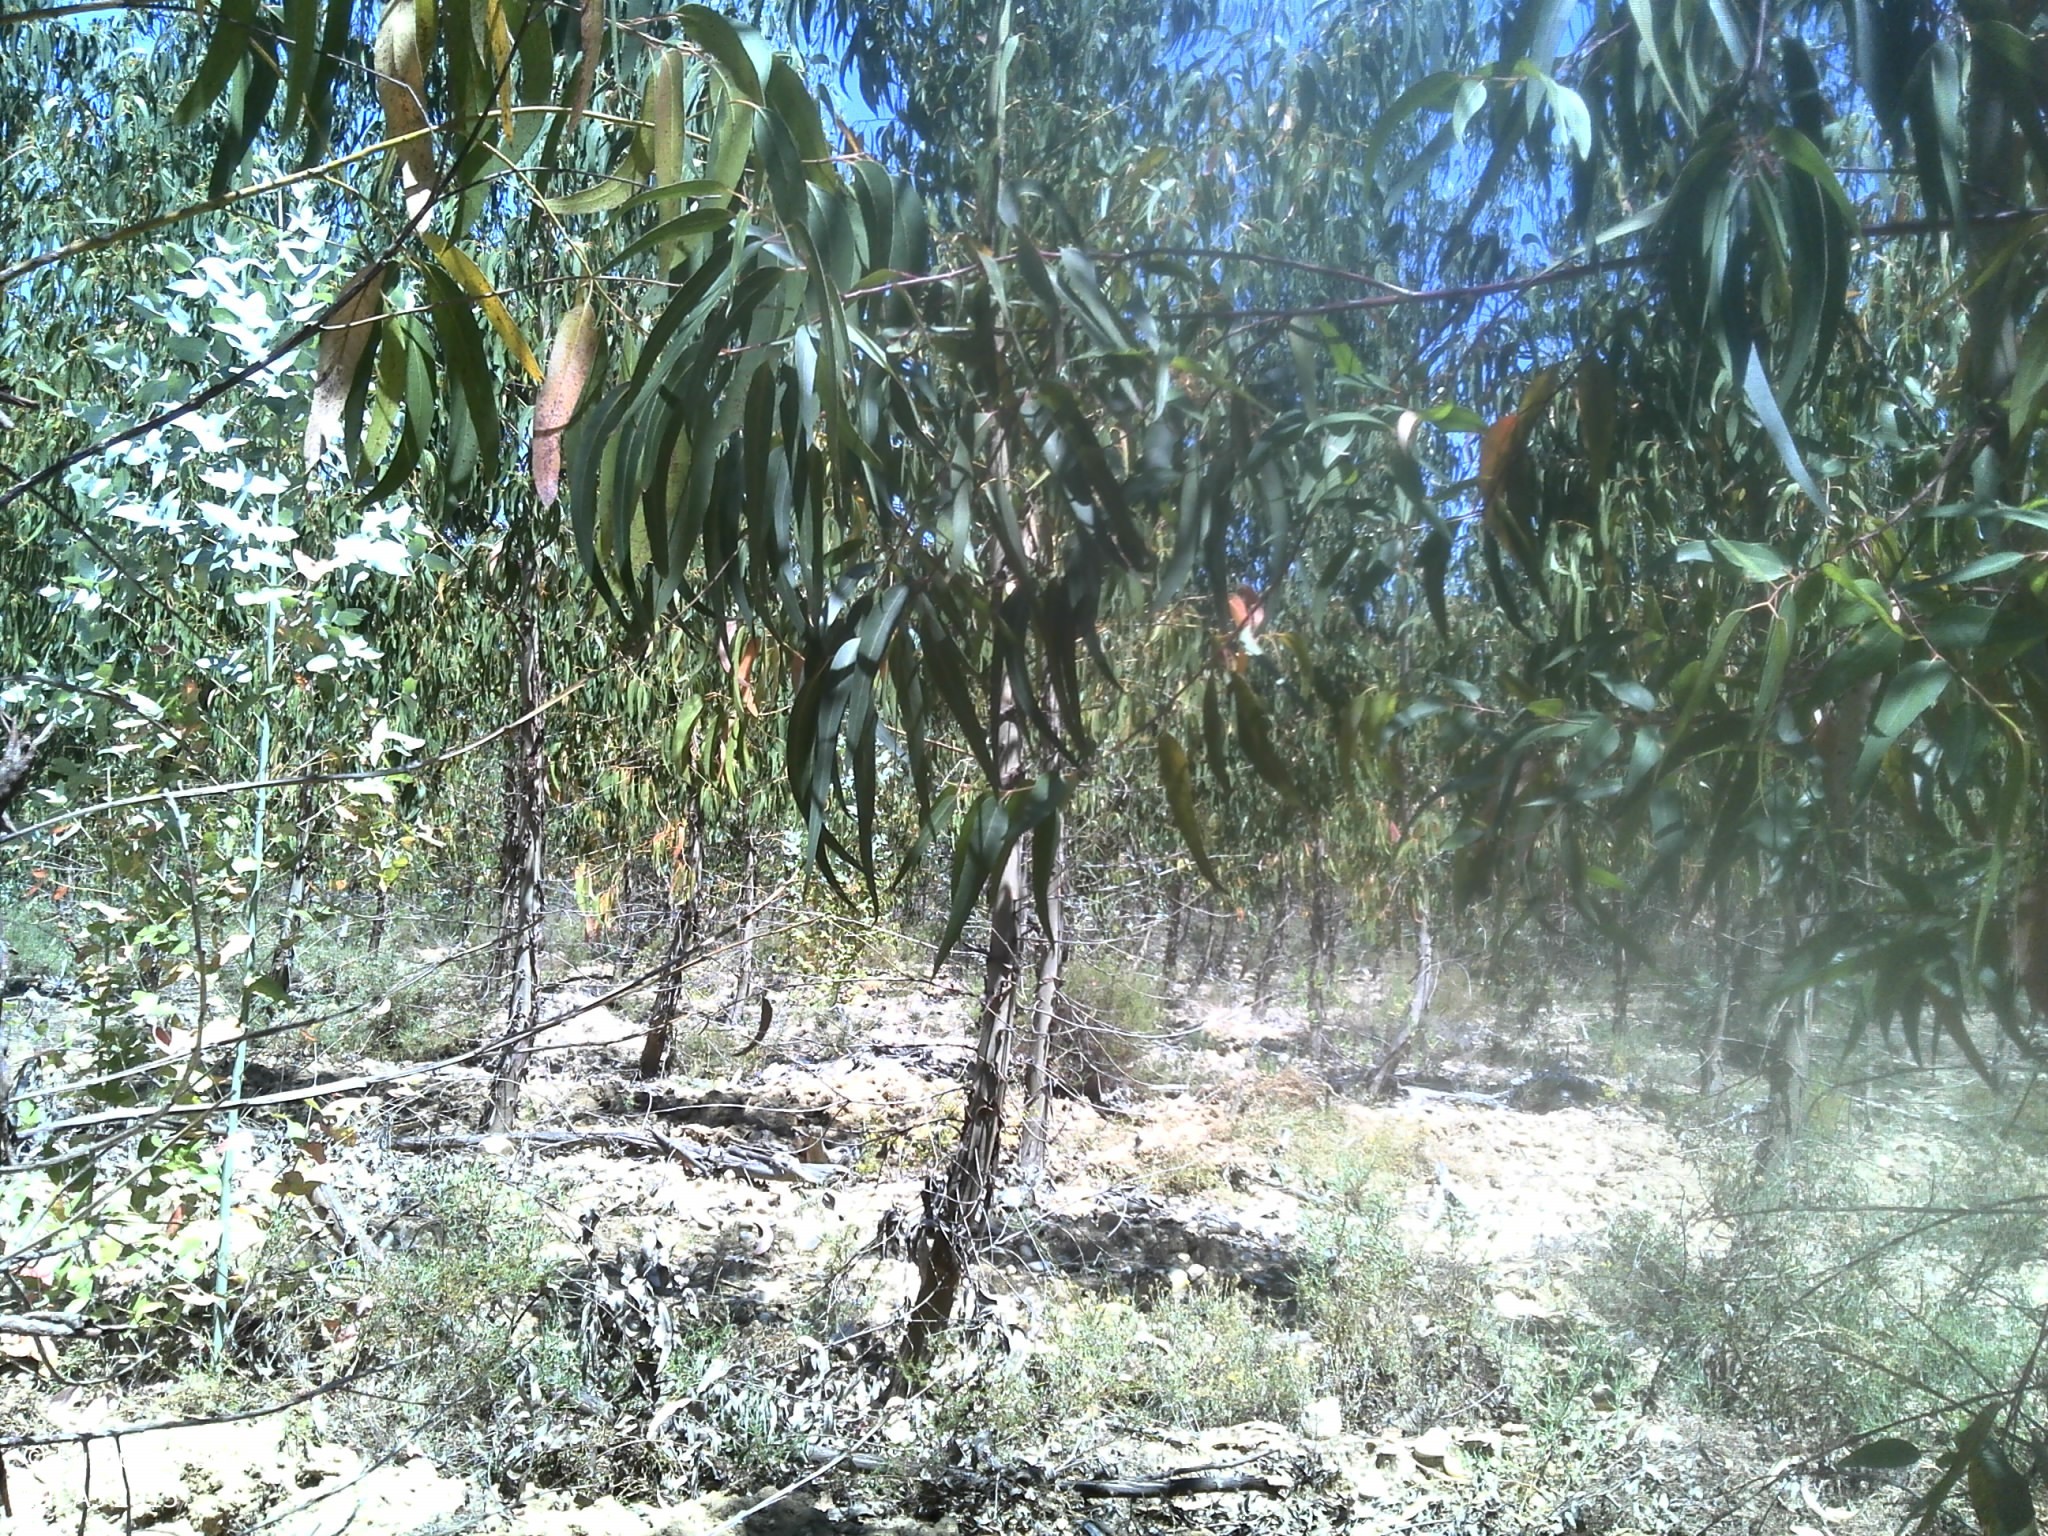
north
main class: Woodland
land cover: Broadleaved woodland
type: exotic forest
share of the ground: 25 - 50 %
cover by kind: broadleaved forest trees 60 %, shrubs 20 %, herbaceous plants 20 %
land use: Forestry
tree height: > 5 m
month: May
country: PT
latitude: 39.3622
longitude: -8.2976
